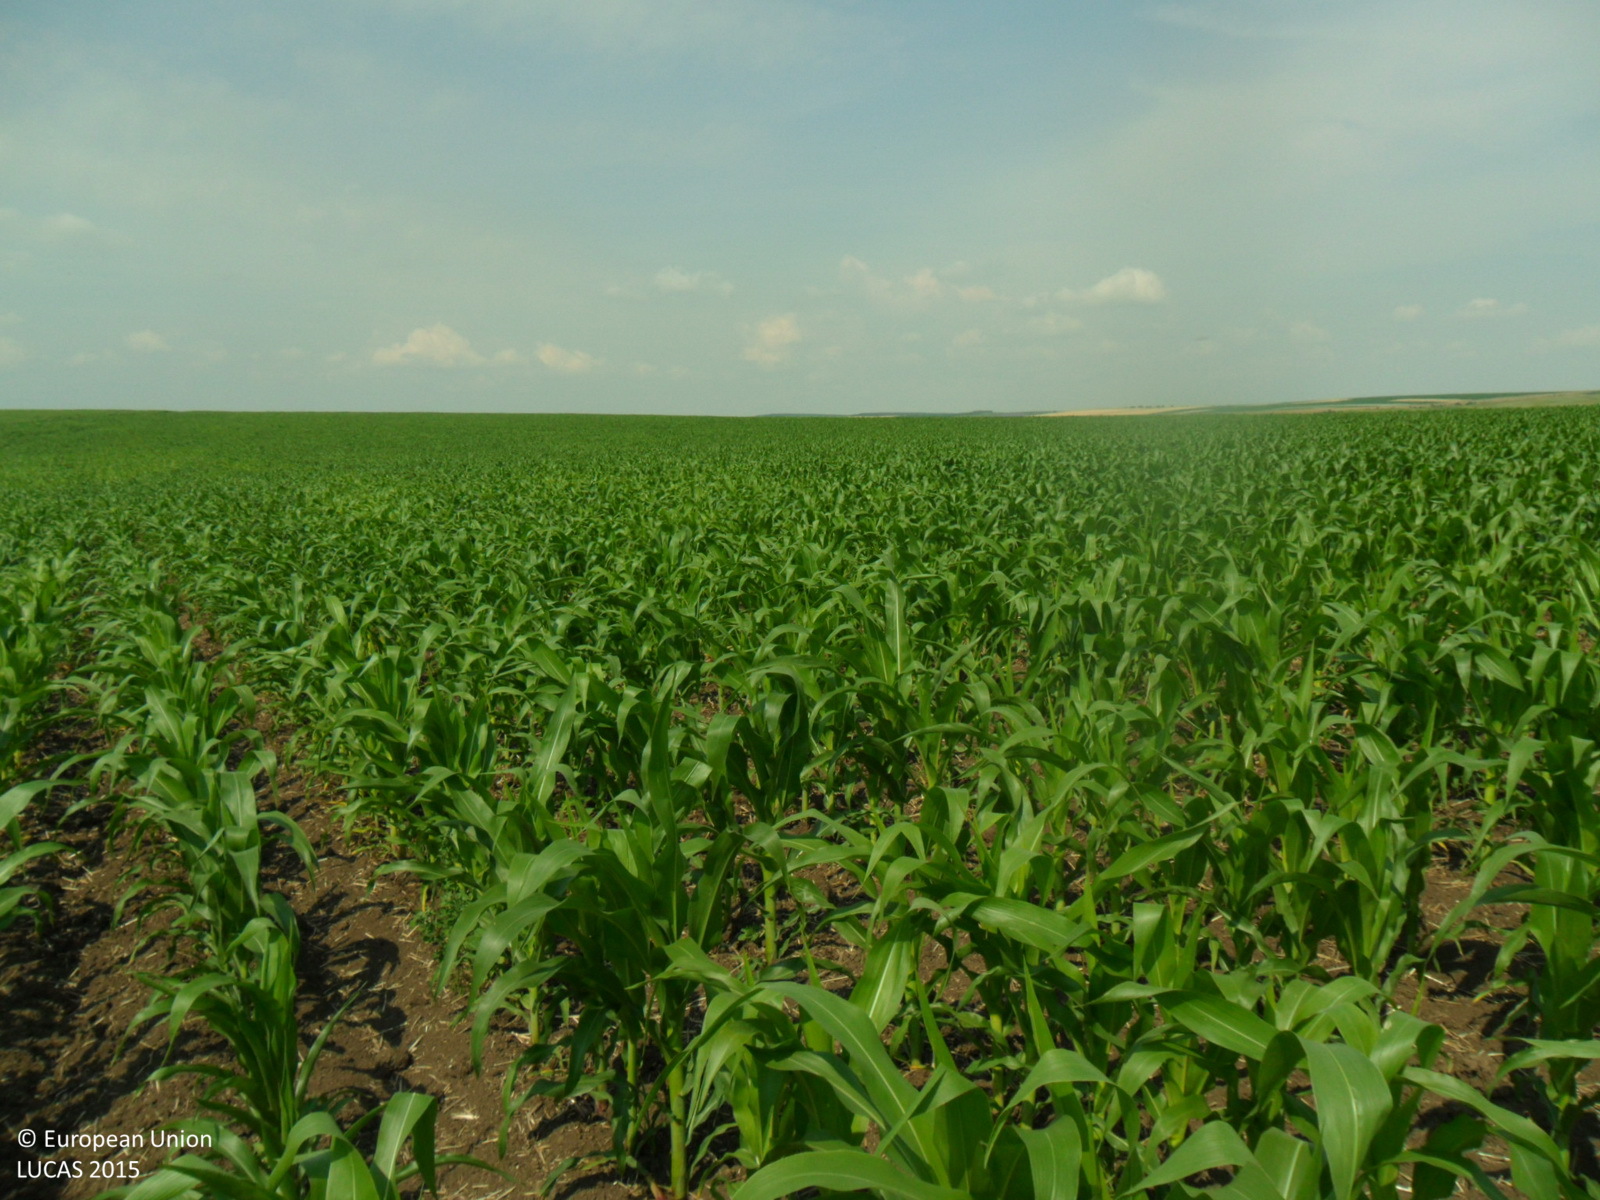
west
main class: Cropland
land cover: Maize
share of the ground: > 75 %
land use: Agriculture (excluding fallow land and kitchen gardens)
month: June
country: BG
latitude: 43.3586
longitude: 26.7796
